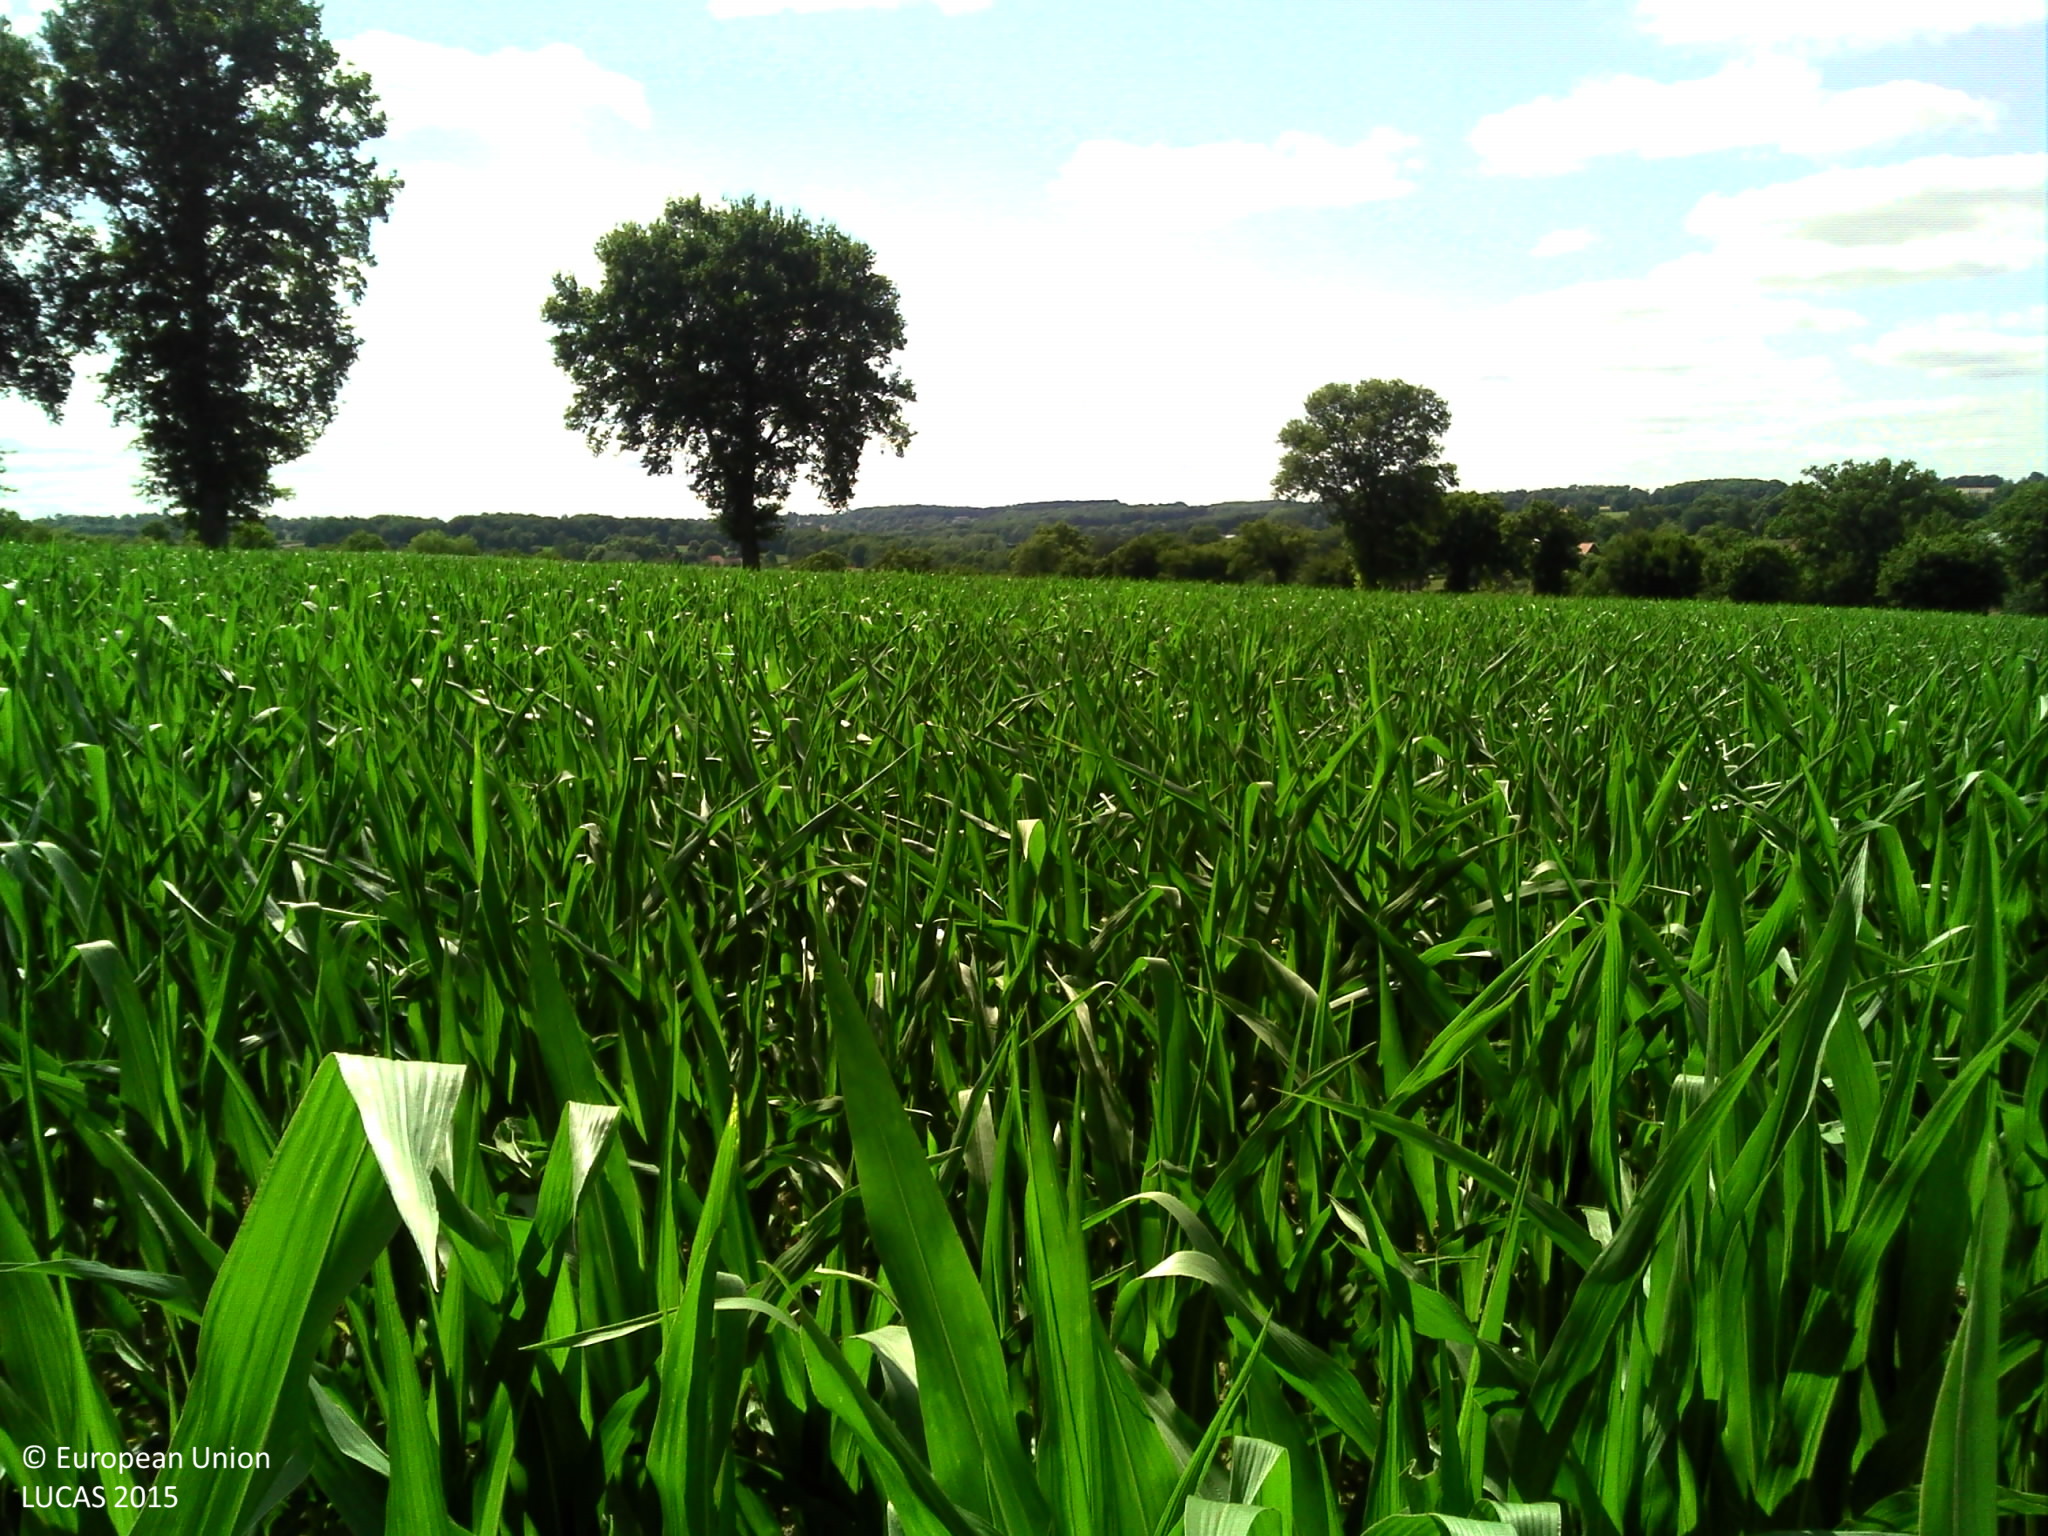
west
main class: Cropland
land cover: Maize
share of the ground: > 75 %
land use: Agriculture (excluding fallow land and kitchen gardens)
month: July
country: FR
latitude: 46.3193
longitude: 1.7187
